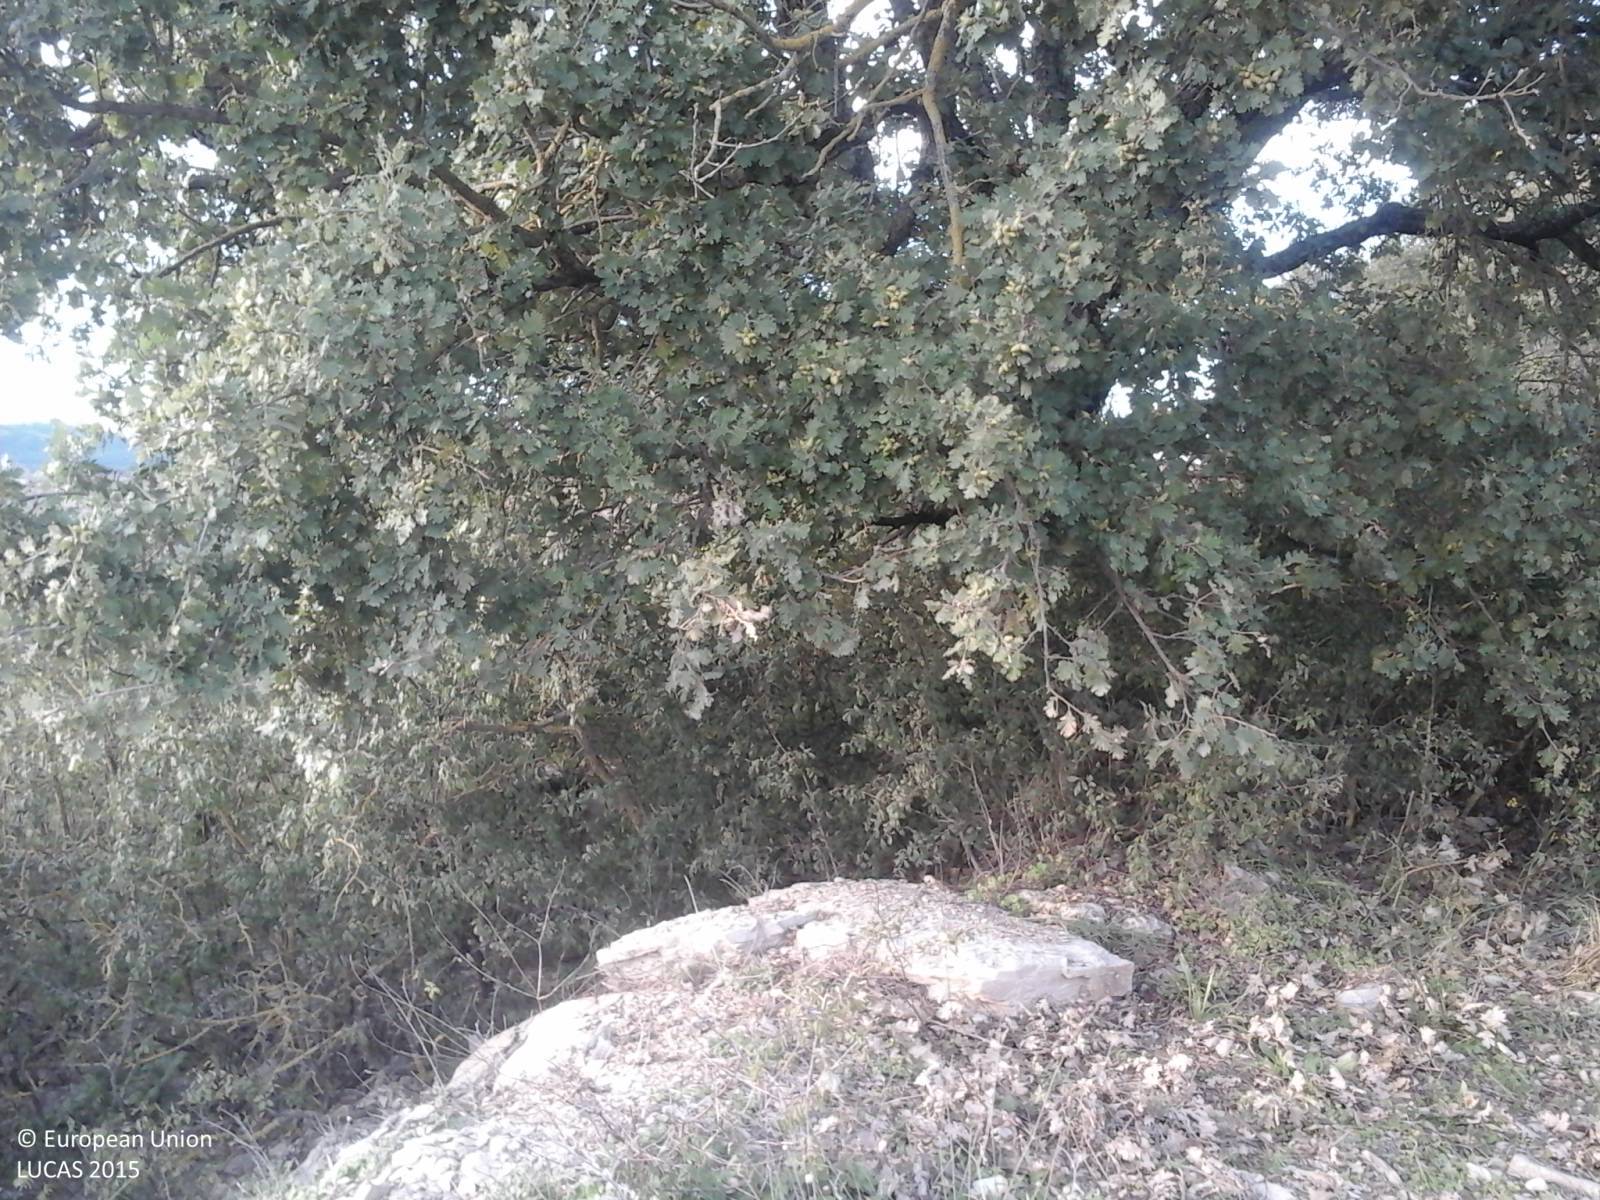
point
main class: Woodland
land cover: Broadleaved woodland
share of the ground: > 75 %
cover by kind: broadleaved forest trees 70 %, shrubs 30 %
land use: Agriculture (excluding fallow land and kitchen gardens)
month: October
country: IT
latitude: 42.7729
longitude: 12.2783
